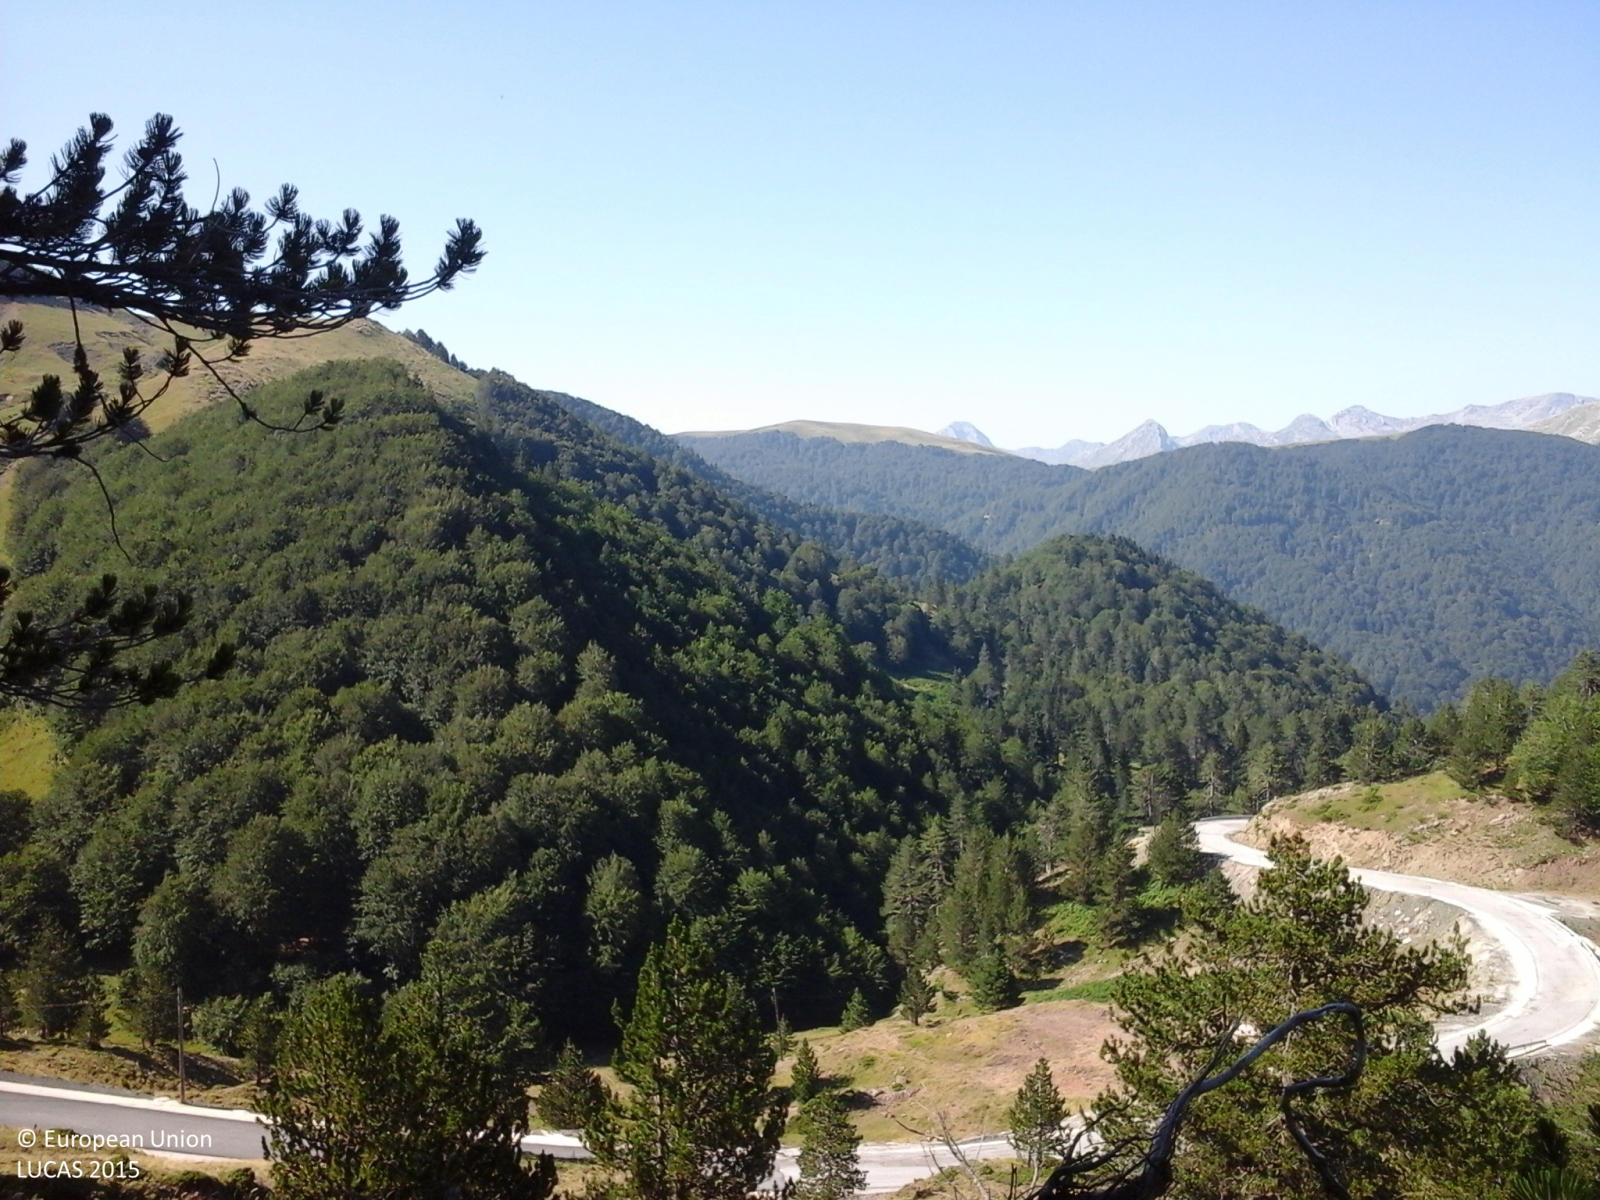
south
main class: Woodland
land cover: Pine dominated coniferous woodland
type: coniferous forest of the mediterranean region
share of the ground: 50 - 75 %
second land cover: Grassland without tree/shrub cover
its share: 10 - 25 %
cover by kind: coniferous forest trees 70 %, herbaceous plants 20 %, consolidated bare surface 10 %
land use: Forestry
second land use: Agriculture (excluding fallow land and kitchen gardens)
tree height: > 5 m
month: July
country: GR
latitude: 39.7493
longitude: 21.2205
